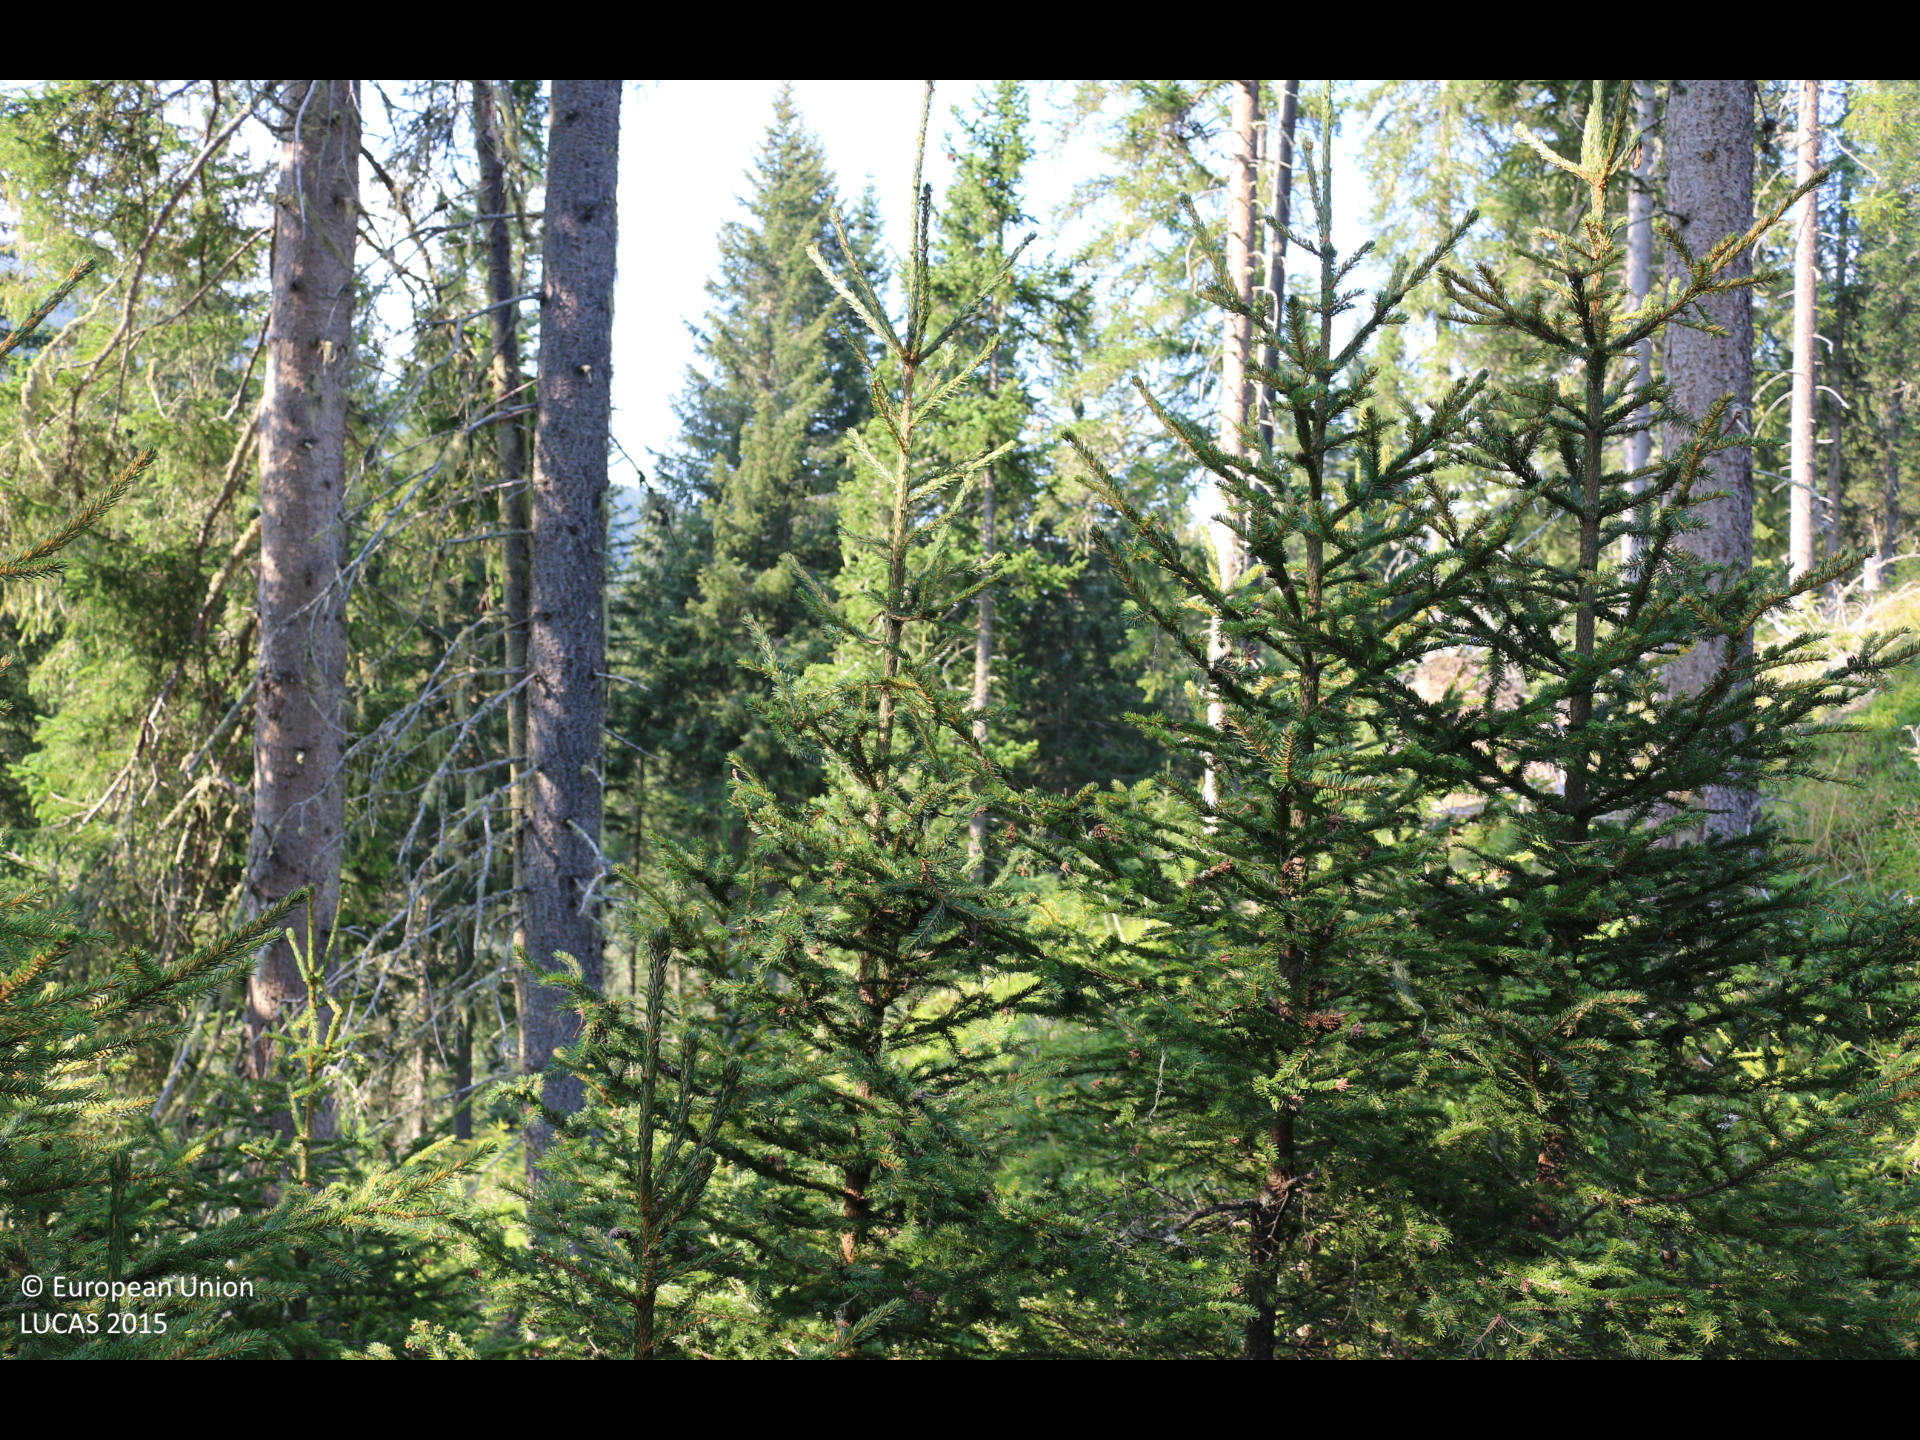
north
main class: Woodland
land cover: Spruce dominated coniferous woodland
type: alpine coniferous forest
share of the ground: > 75 %
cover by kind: coniferous forest trees 90 %, shrubs 5 %, lichens and mosses 5 %
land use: Forestry
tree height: > 5 m
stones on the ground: 10 - 25 %
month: August
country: AT
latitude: 46.9793
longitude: 14.0074
